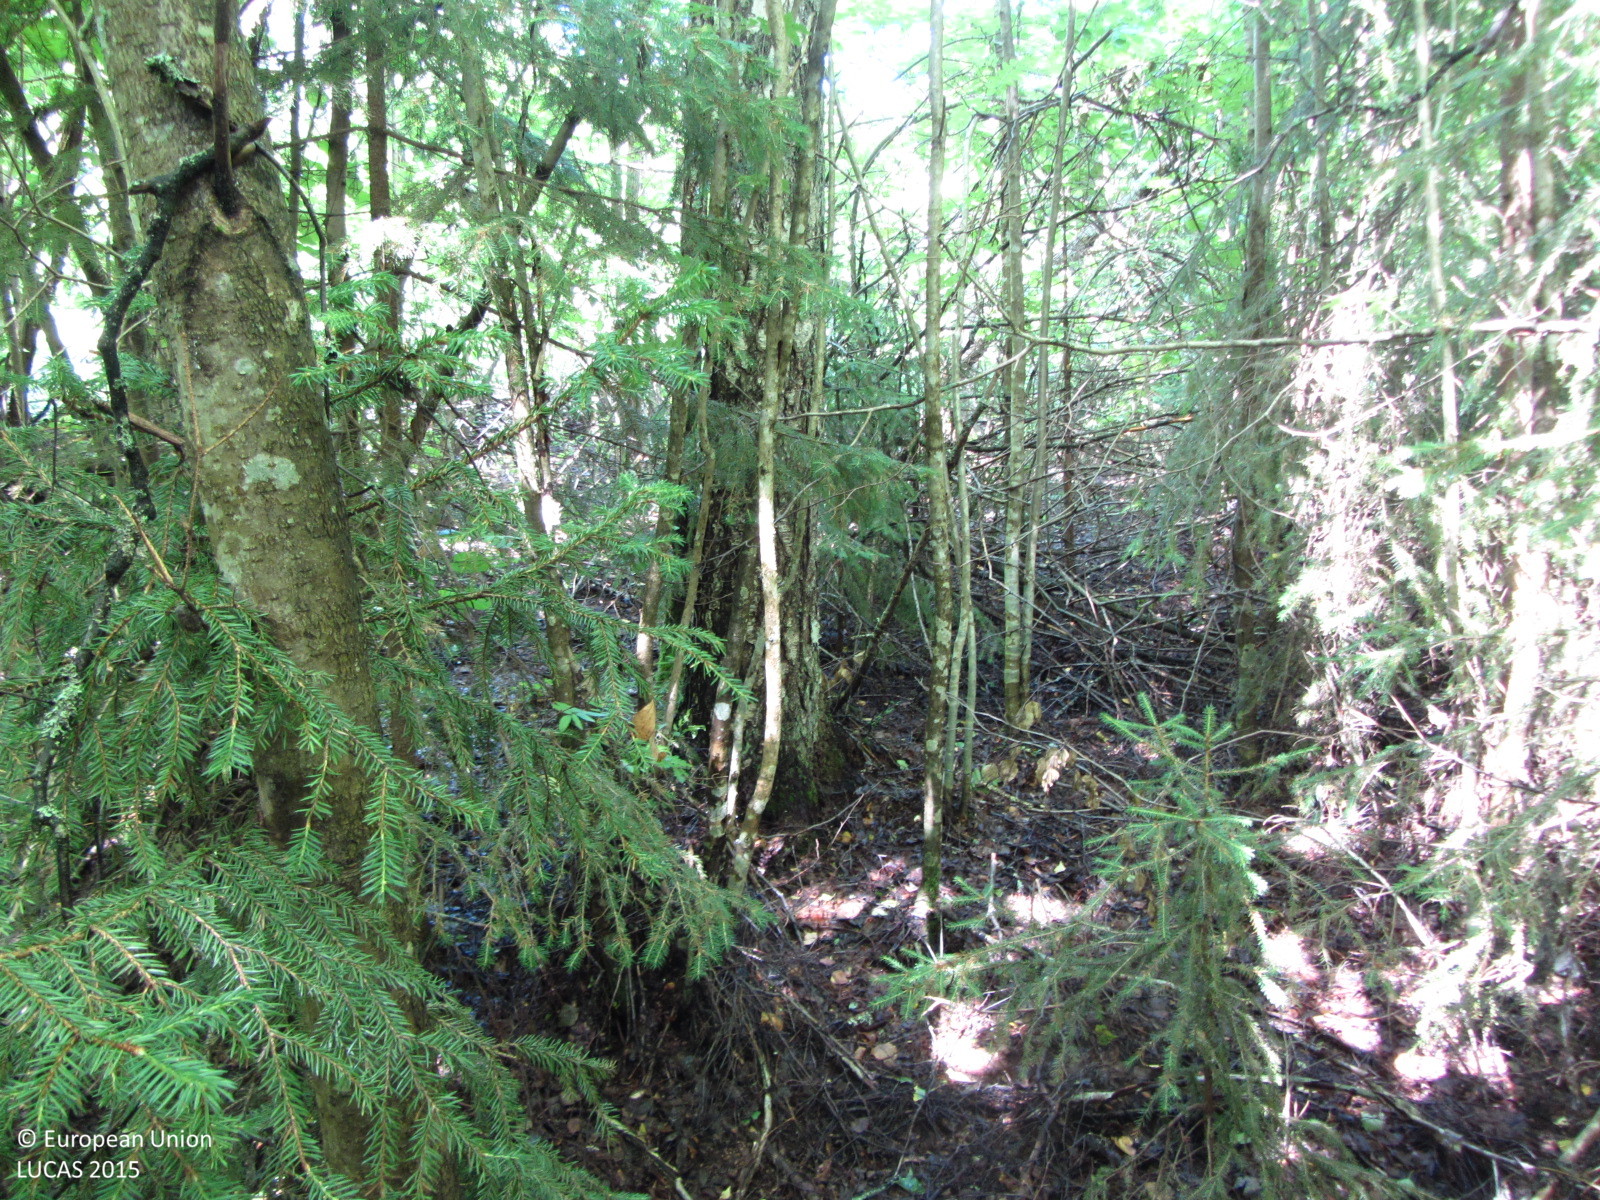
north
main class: Woodland
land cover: Spruce dominated mixed woodland
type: hemiboreal forest and nemoral coniferous forest and mixed broadleaved-coniferous forest
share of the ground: > 75 %
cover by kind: broadleaved forest trees 55 %, coniferous forest trees 35 %, herbaceous plants 10 %
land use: Forestry
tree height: > 5 m
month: July
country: FI
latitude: 60.1841
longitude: 24.4415
